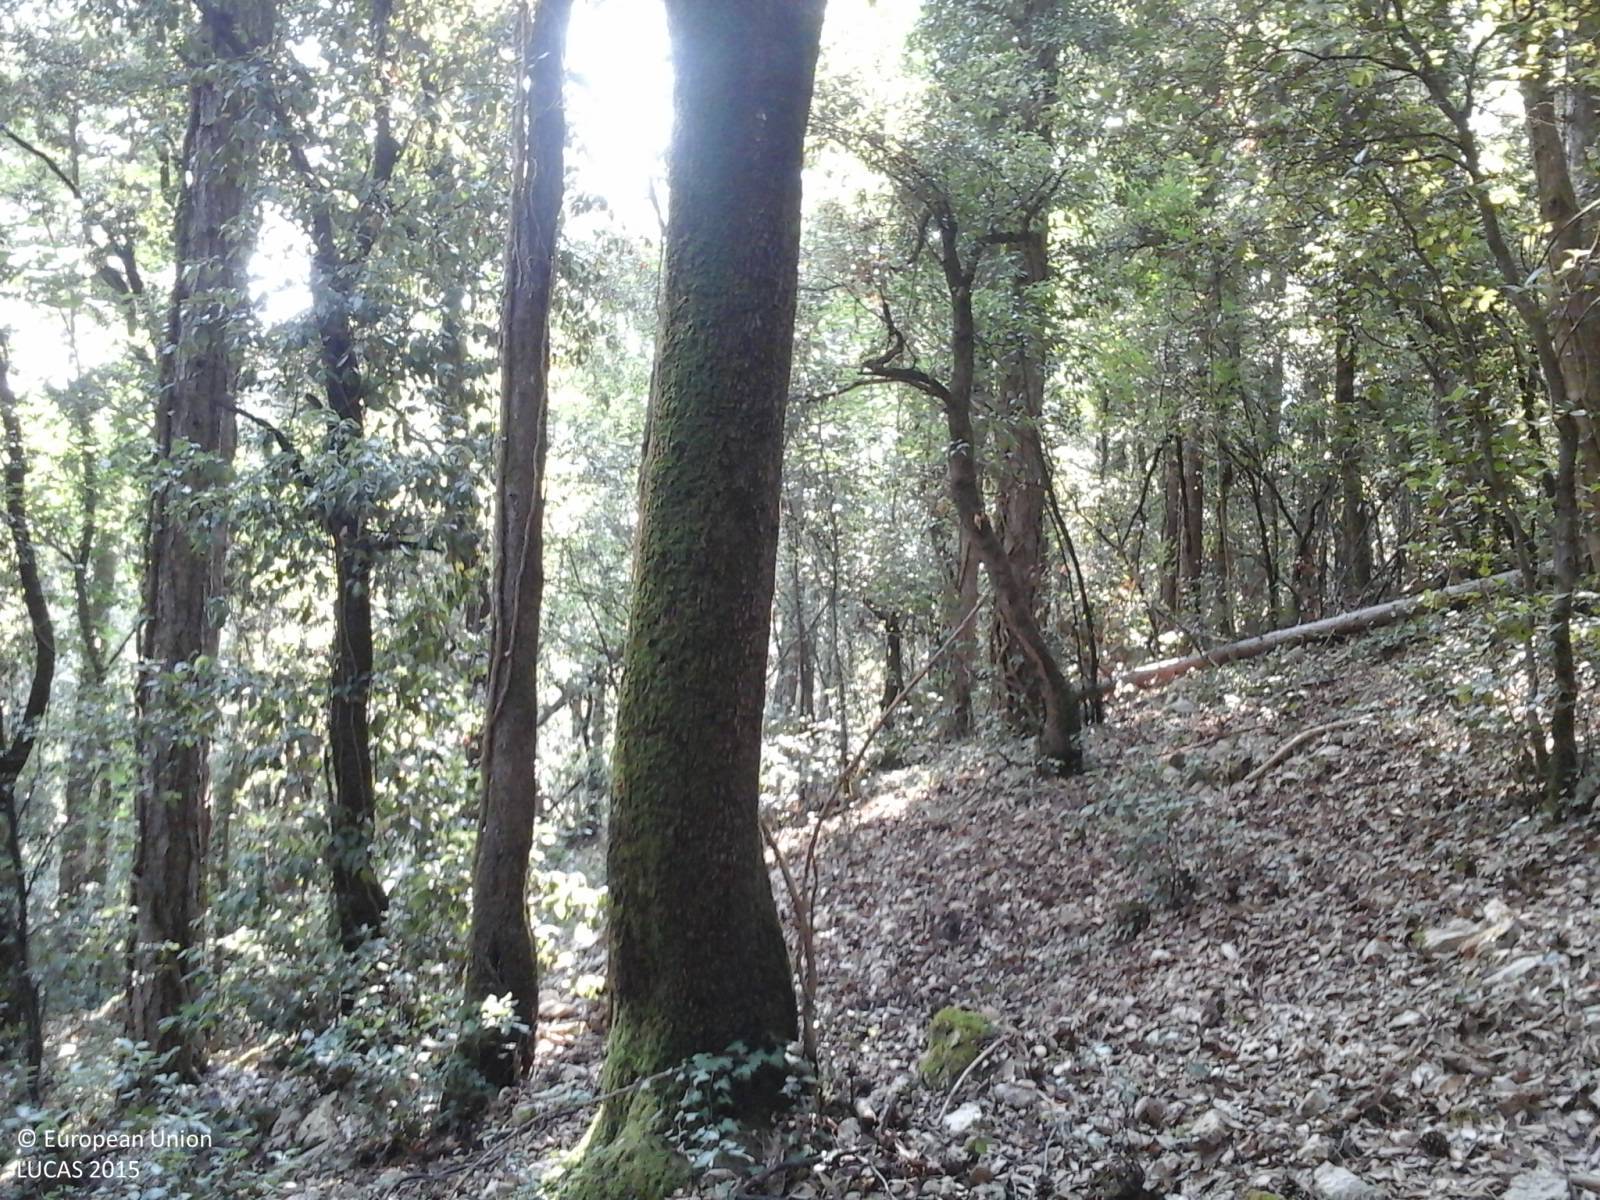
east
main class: Woodland
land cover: Other mixed woodland
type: coniferous forest of the mediterranean region
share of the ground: > 75 %
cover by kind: coniferous forest trees 60 %, broadleaved forest trees 40 %
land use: Forestry
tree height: > 5 m
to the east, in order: Other mixed woodland; Pine dominated coniferous woodland
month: July
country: IT
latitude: 42.3447
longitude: 13.3757
